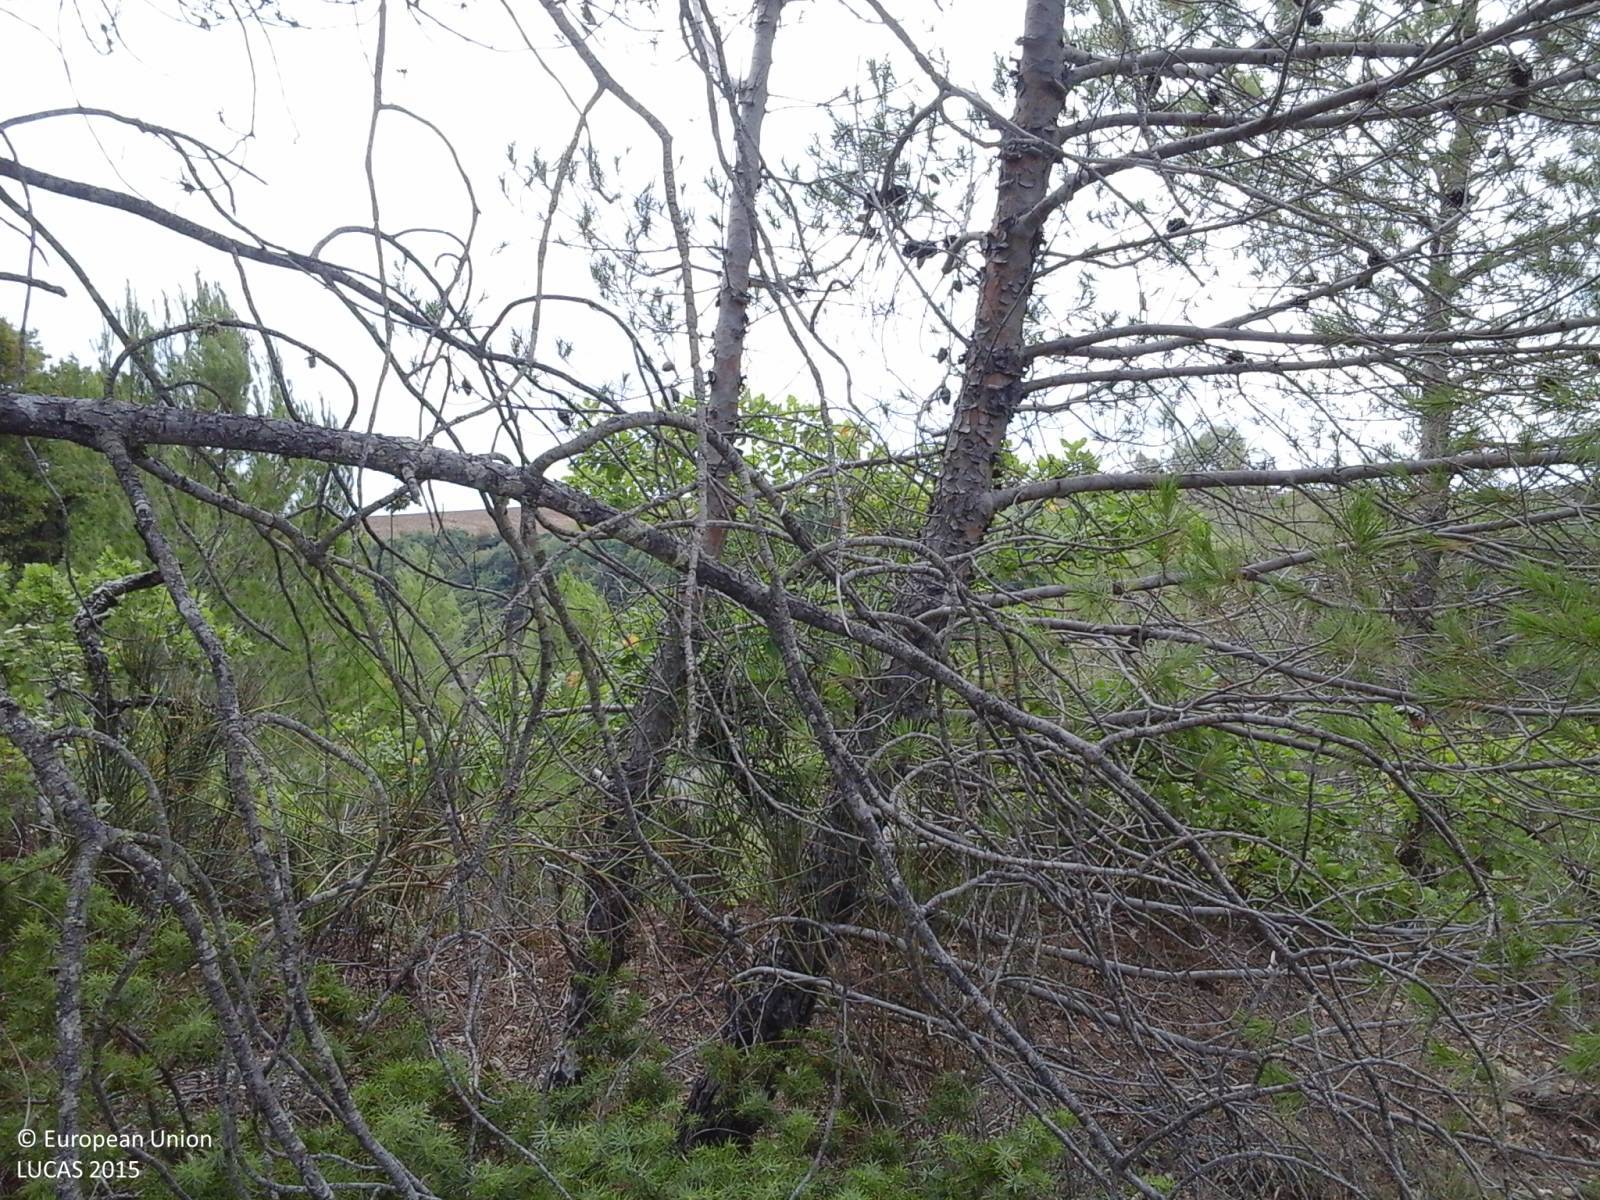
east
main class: Woodland
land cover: Broadleaved woodland
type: thermophilous deciduous forest
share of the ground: > 75 %
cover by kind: broadleaved forest trees 100 %
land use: Forestry
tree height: > 5 m
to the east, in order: Broadleaved woodland; Pine dominated coniferous woodland; Rocks and stones; Pine dominated coniferous woodland; Rocks and stones
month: September
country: IT
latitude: 42.9179
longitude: 12.2594
